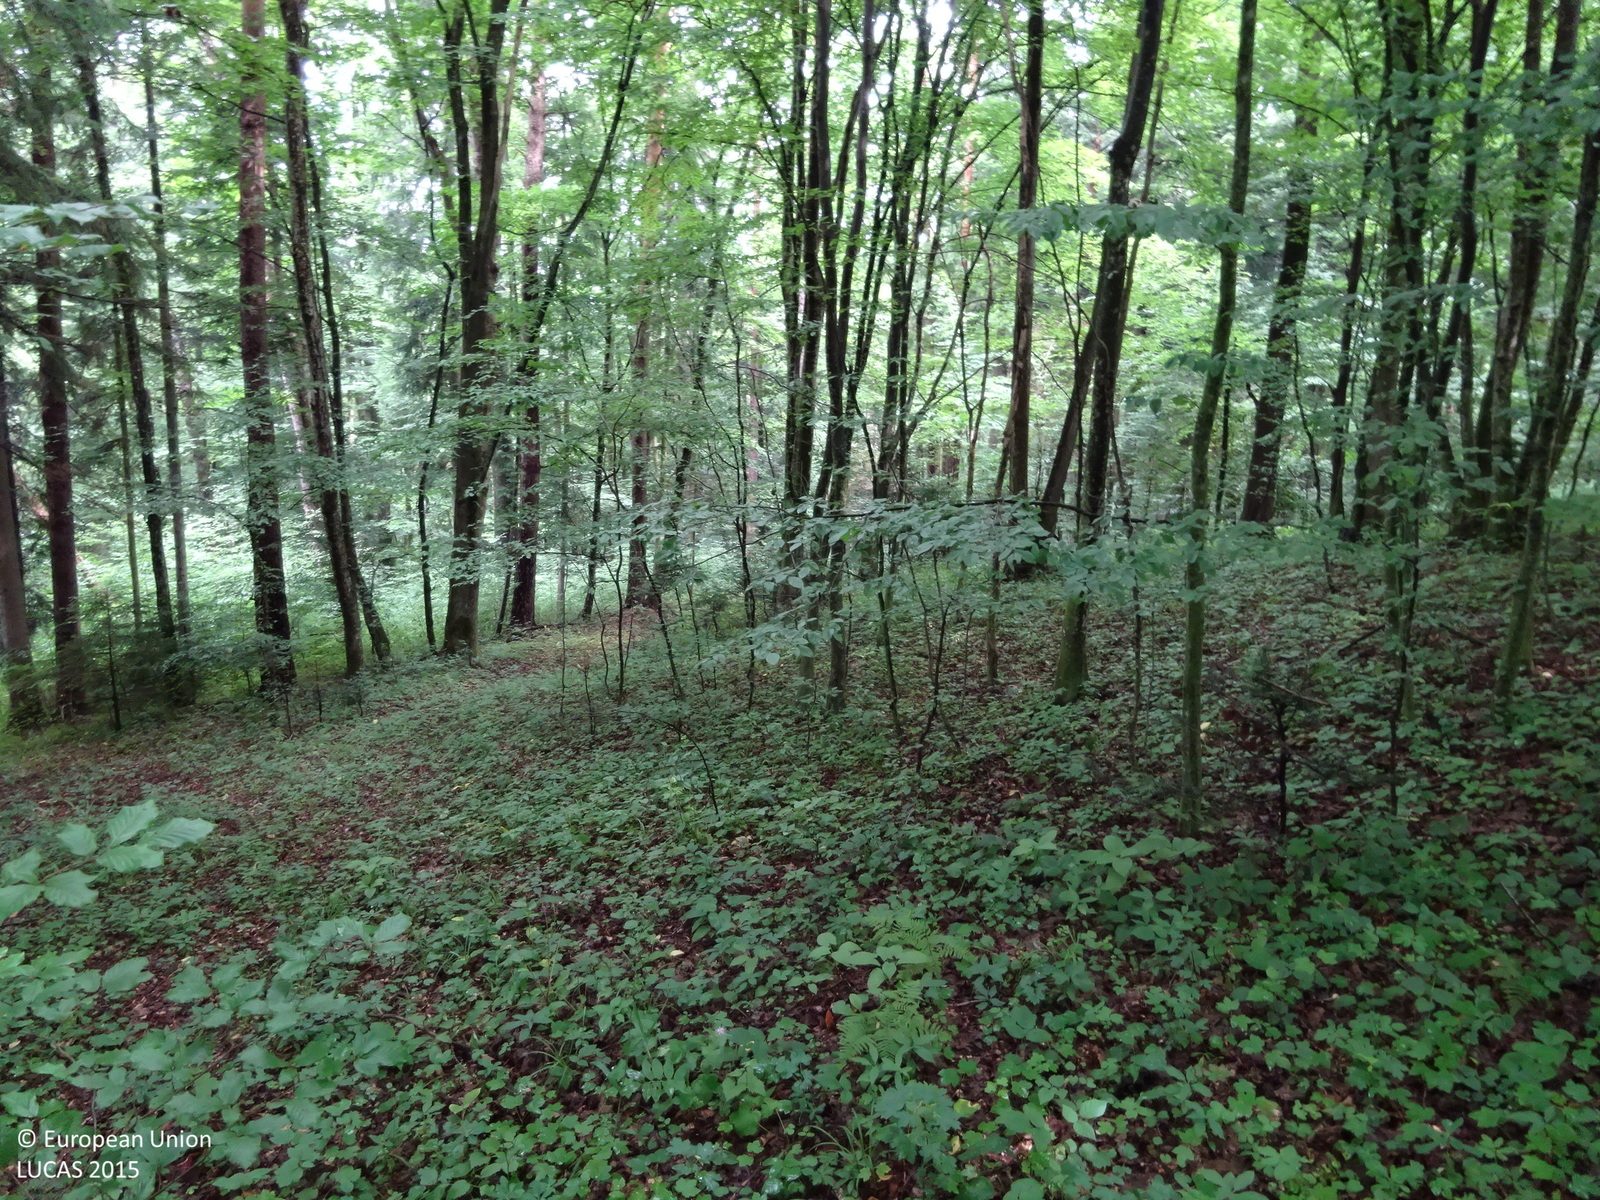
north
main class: Woodland
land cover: Broadleaved woodland
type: mountainous beech forest
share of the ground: > 75 %
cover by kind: broadleaved forest trees 80 %, coniferous forest trees 10 %, herbaceous plants 10 %
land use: Forestry
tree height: > 5 m
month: June
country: AT
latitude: 46.6662
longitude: 15.3968
